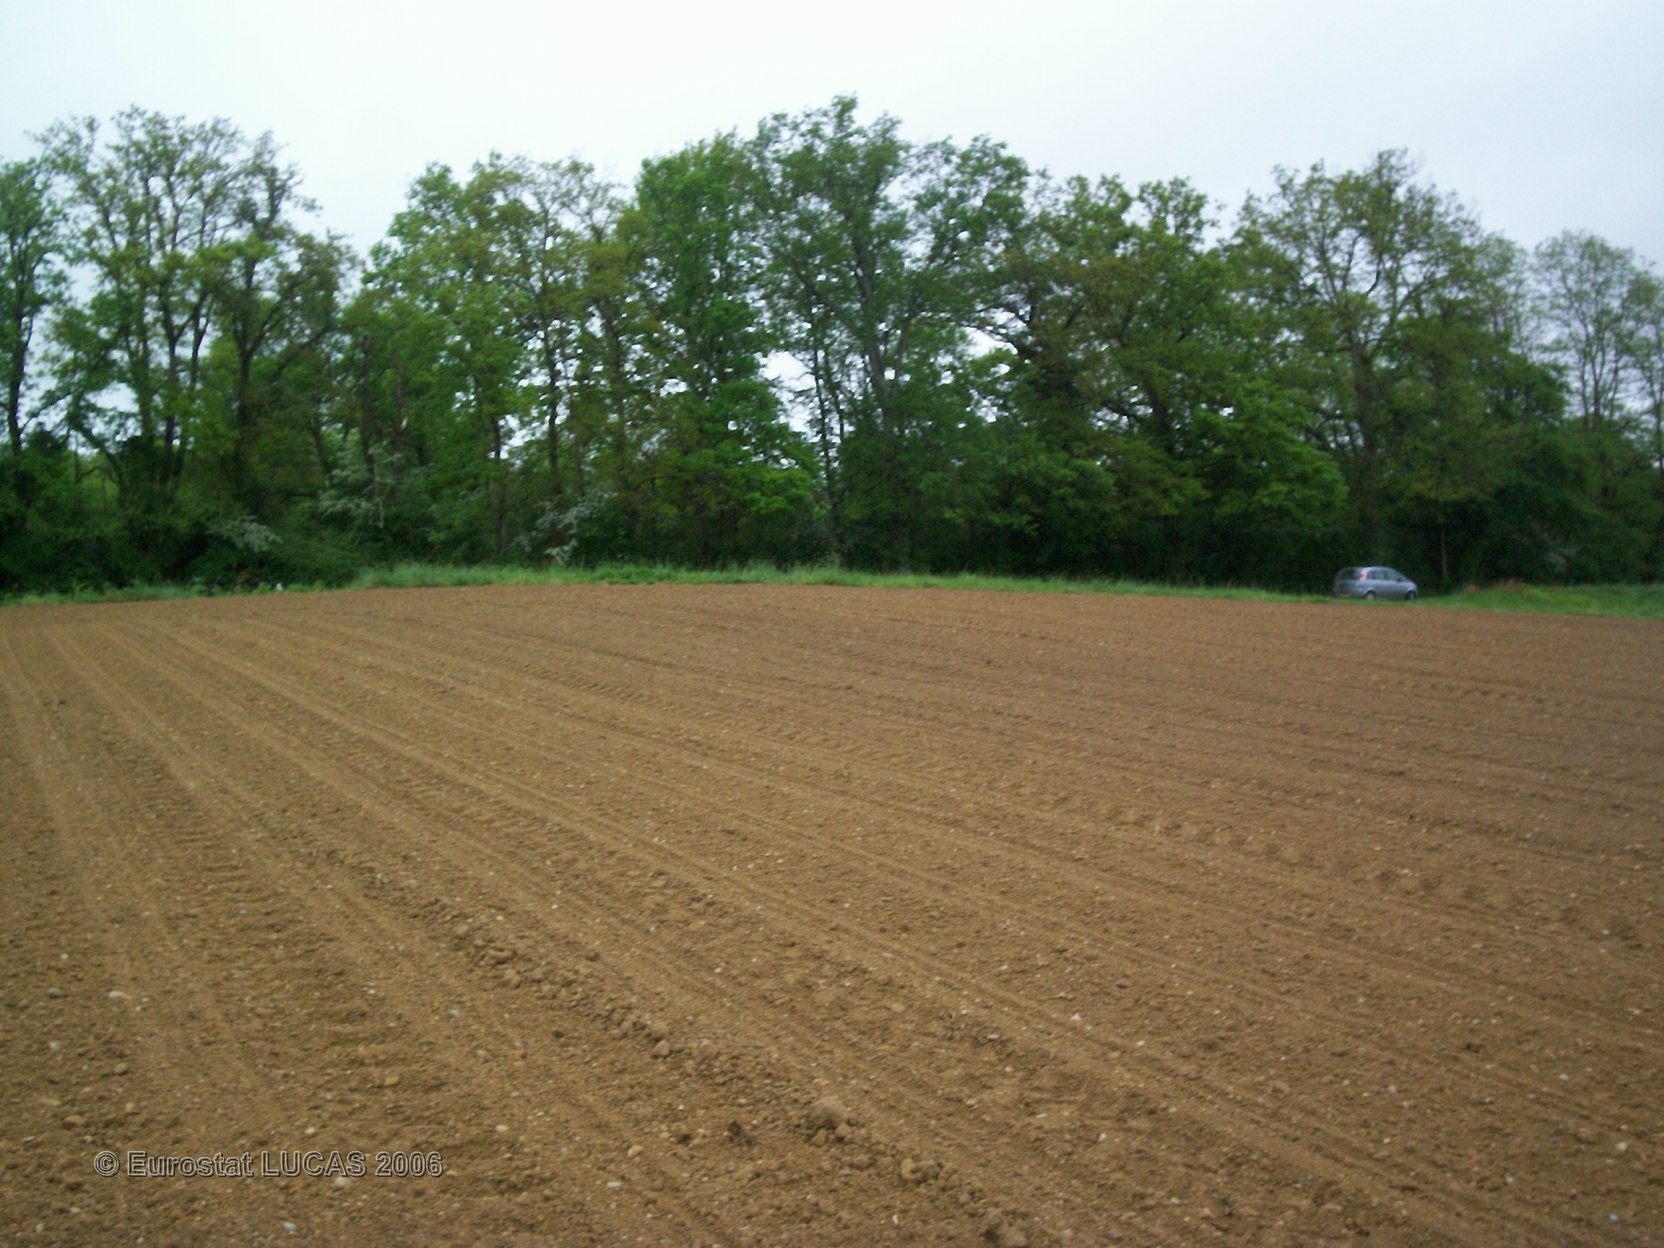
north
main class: Cropland
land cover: Maize
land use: Agriculture (excluding fallow land and kitchen gardens)
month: April
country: FR
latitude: 43.6488
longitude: -0.3614
